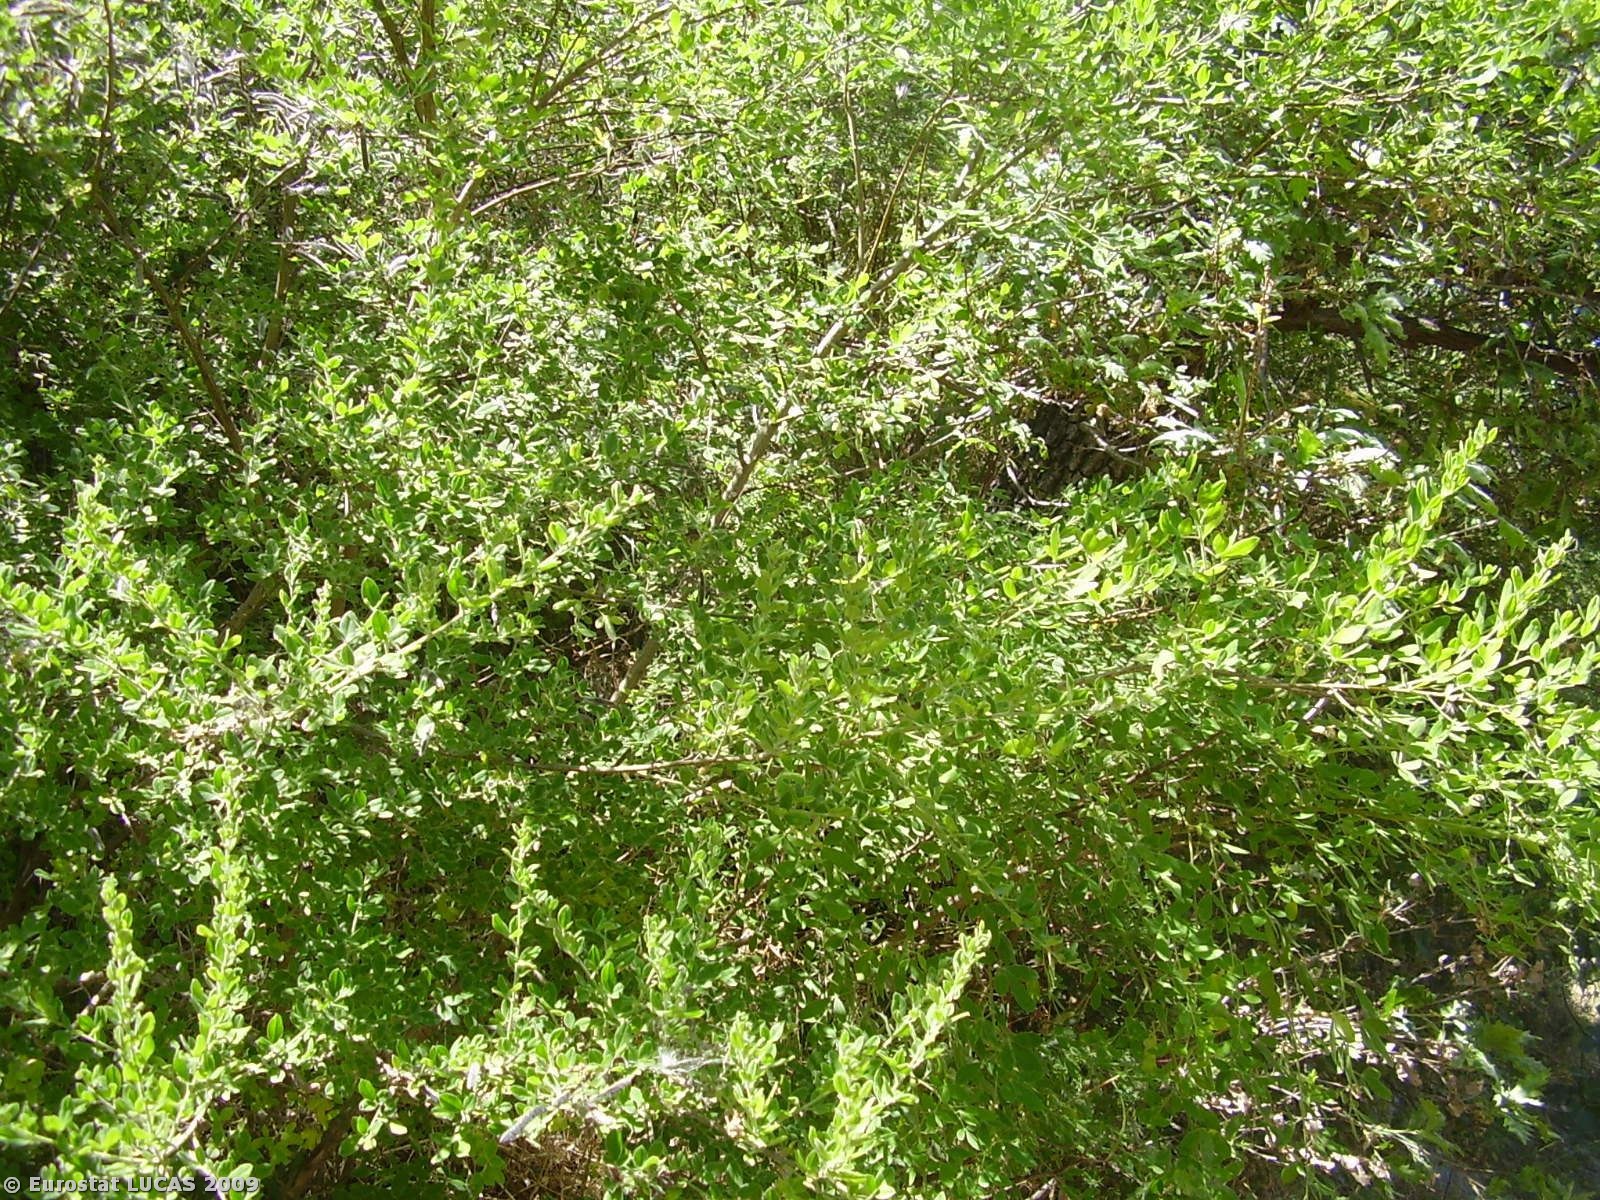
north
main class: Woodland
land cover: Broadleaved woodland
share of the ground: > 75 %
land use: Agriculture (excluding fallow land and kitchen gardens)
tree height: < 5 m
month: June
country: IT
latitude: 37.9994
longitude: 15.3061
